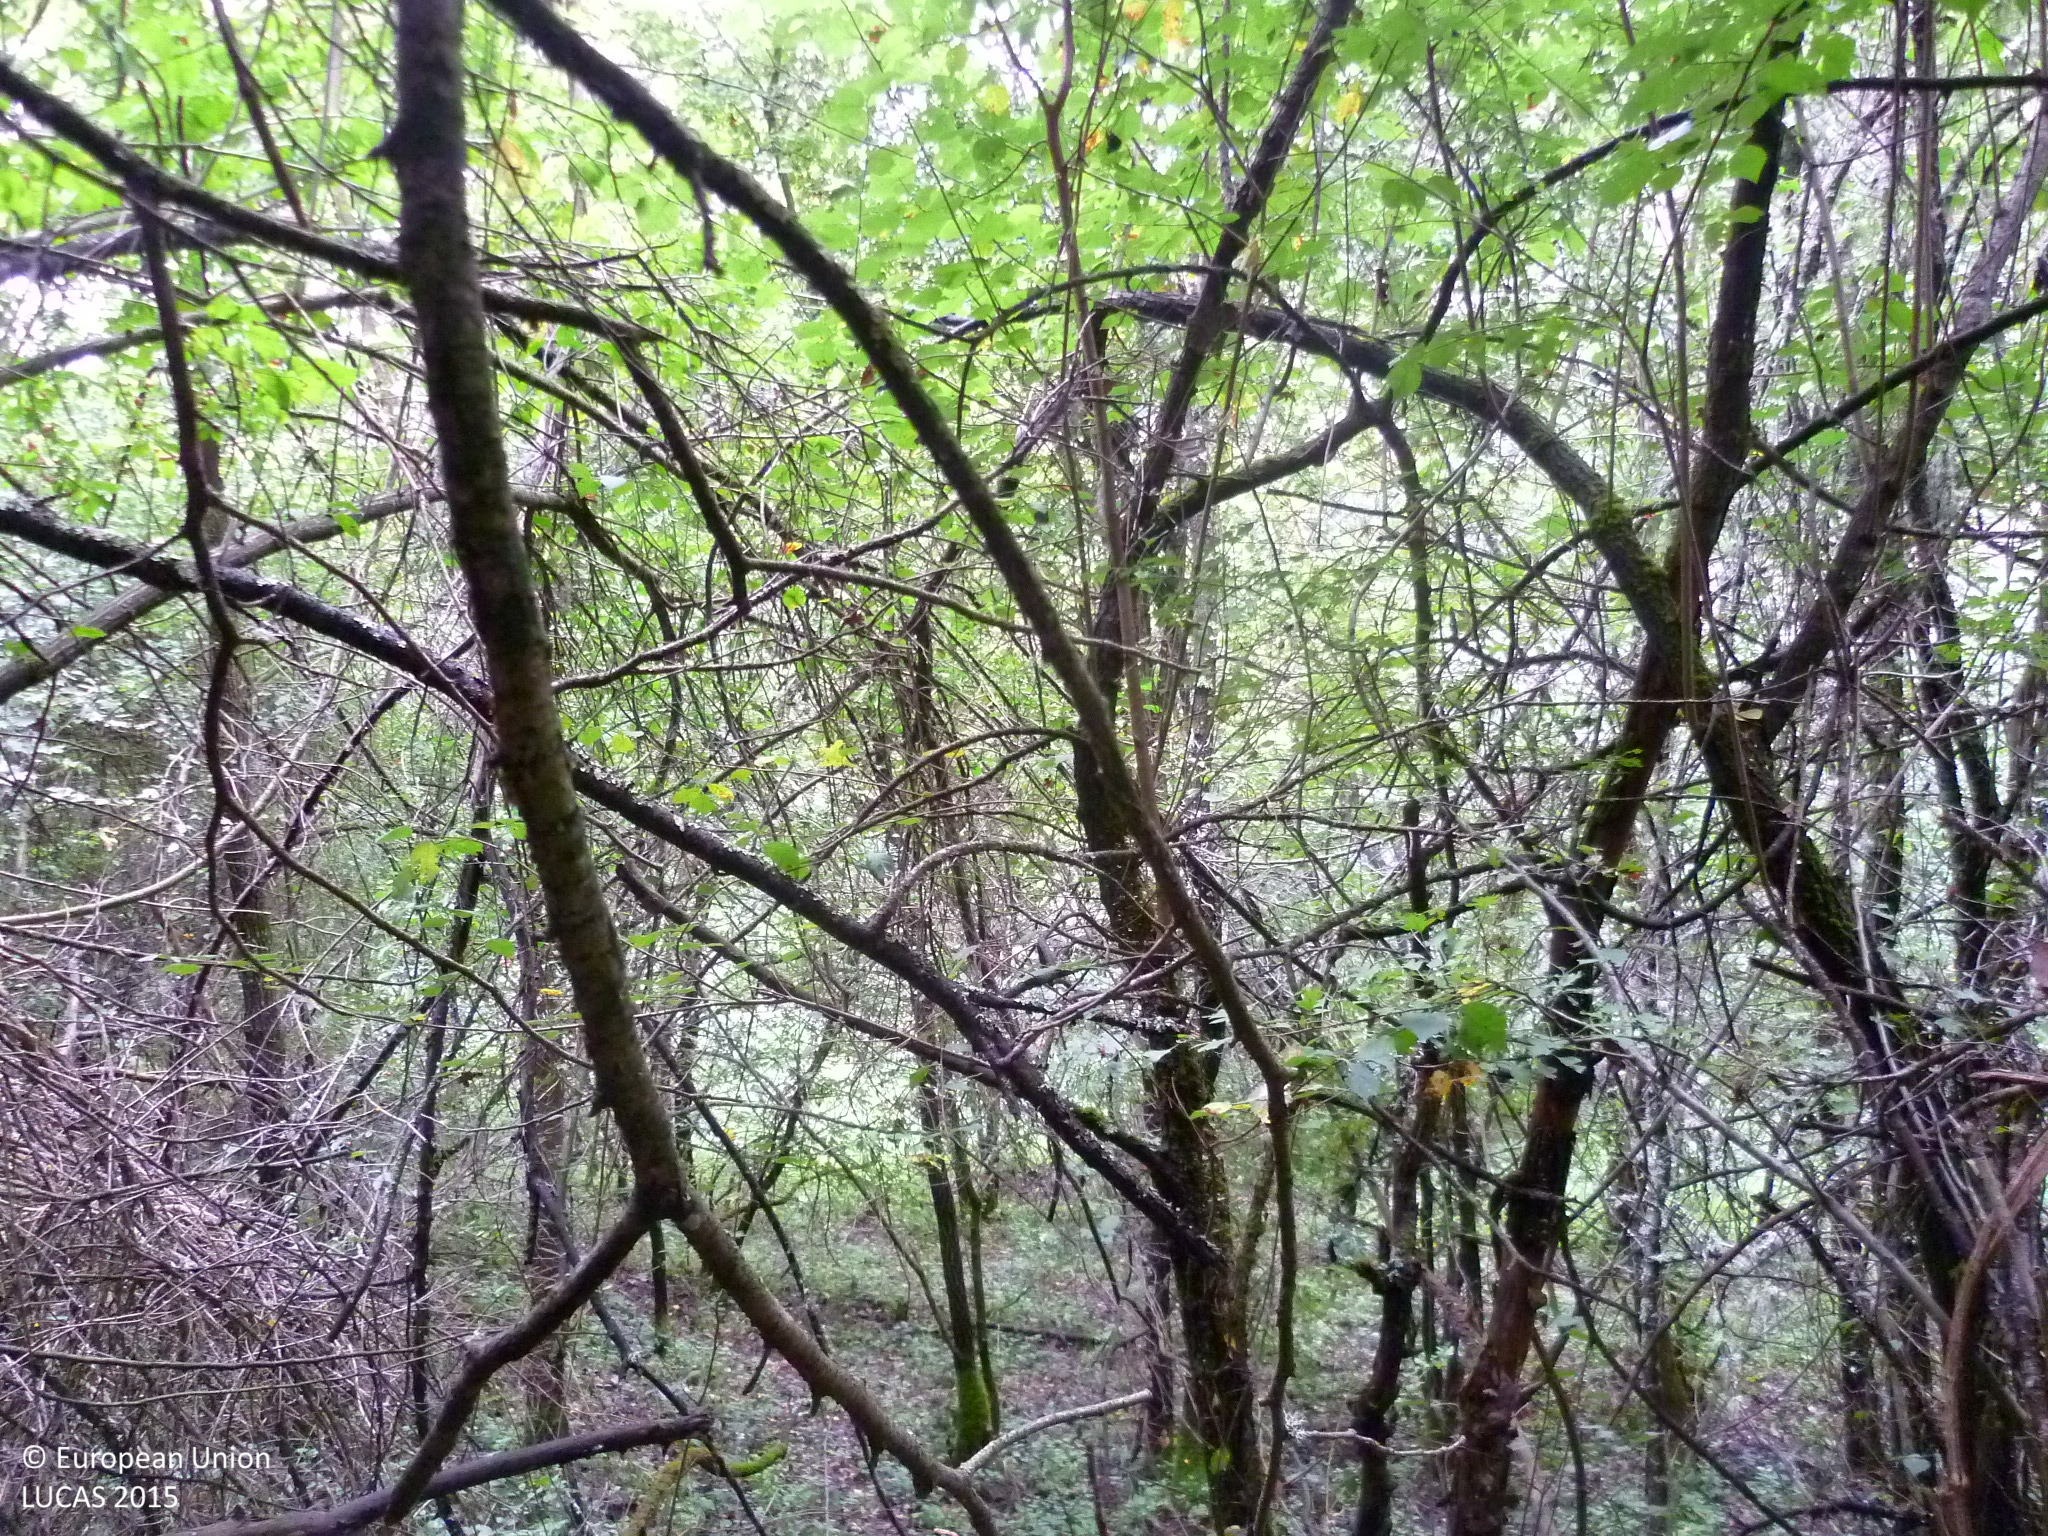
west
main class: Woodland
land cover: Broadleaved woodland
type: mesophytic deciduous forest
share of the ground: > 75 %
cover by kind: broadleaved forest trees 85 %, herbaceous plants 15 %
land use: Forestry
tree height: > 5 m
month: September
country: BG
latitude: 42.5950
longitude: 22.7363
